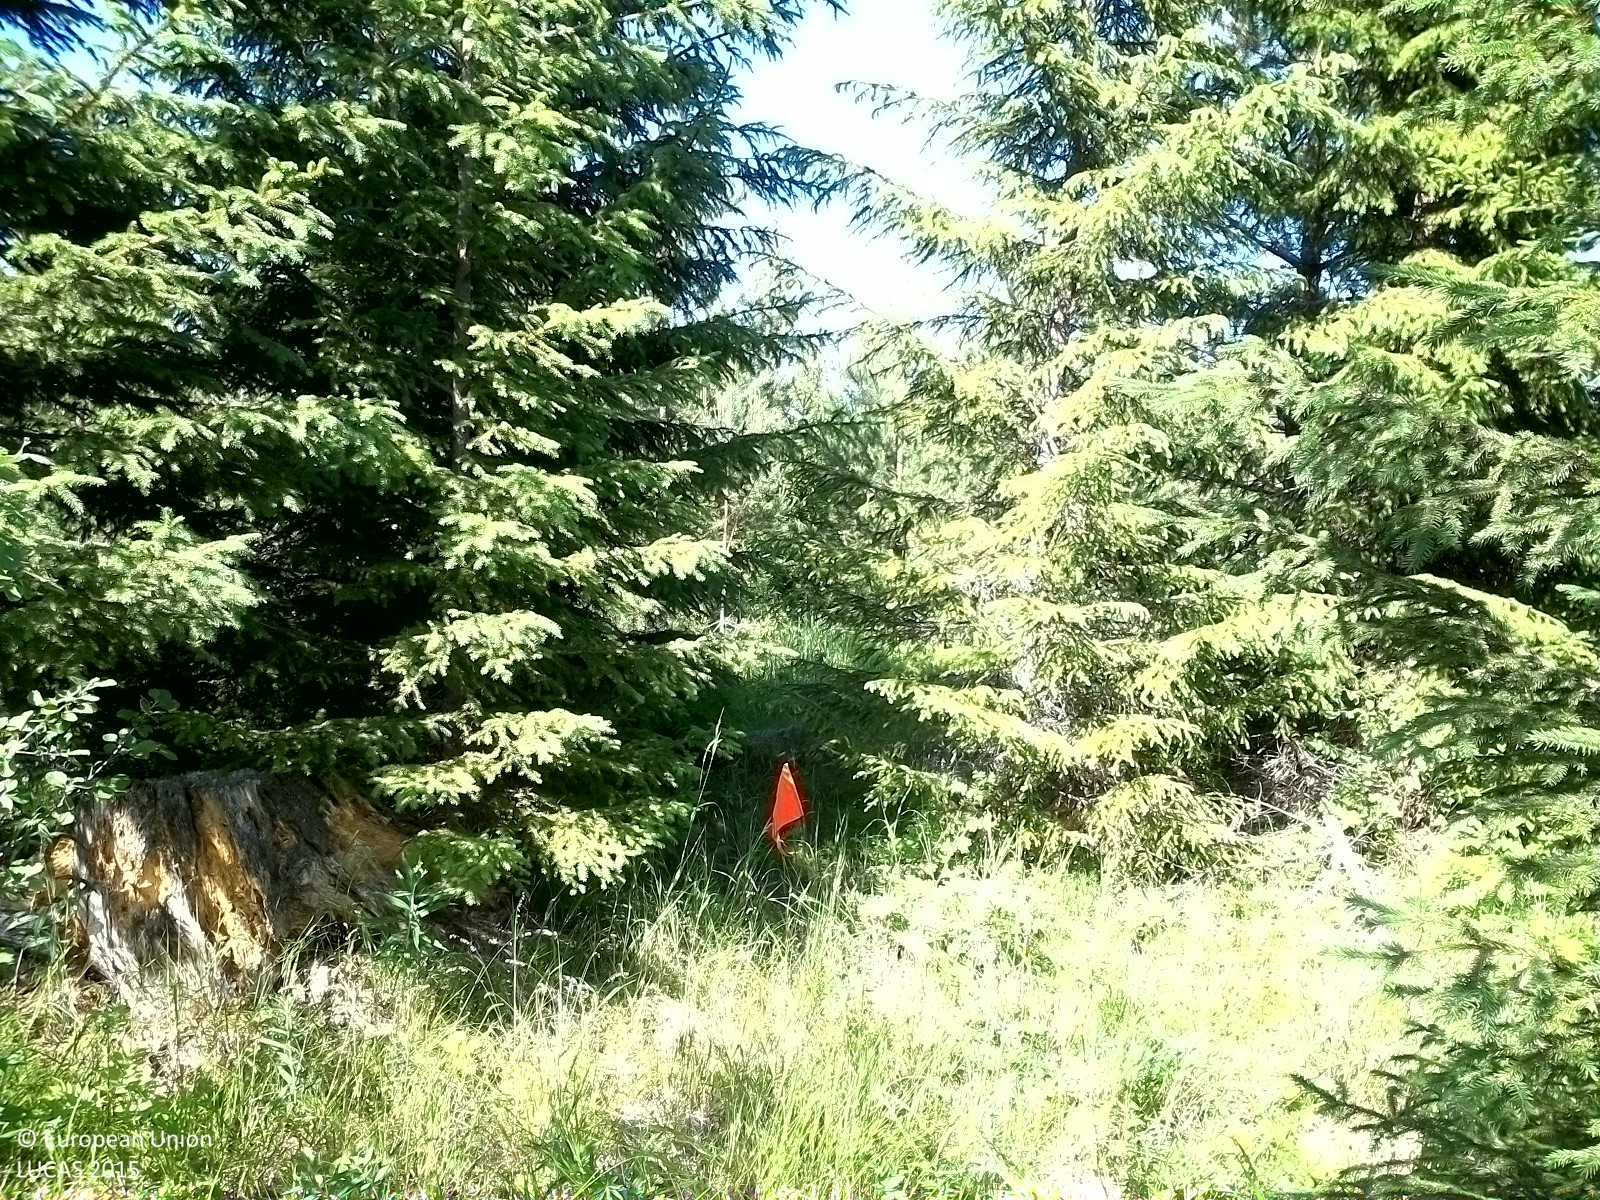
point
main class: Woodland
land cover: Spruce dominated coniferous woodland
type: boreal forest
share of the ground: 25 - 50 %
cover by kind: herbaceous plants 55 %, coniferous forest trees 45 %
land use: Forestry
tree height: > 5 m
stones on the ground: < 10 %
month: July
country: SE
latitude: 62.2177
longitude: 16.9234
